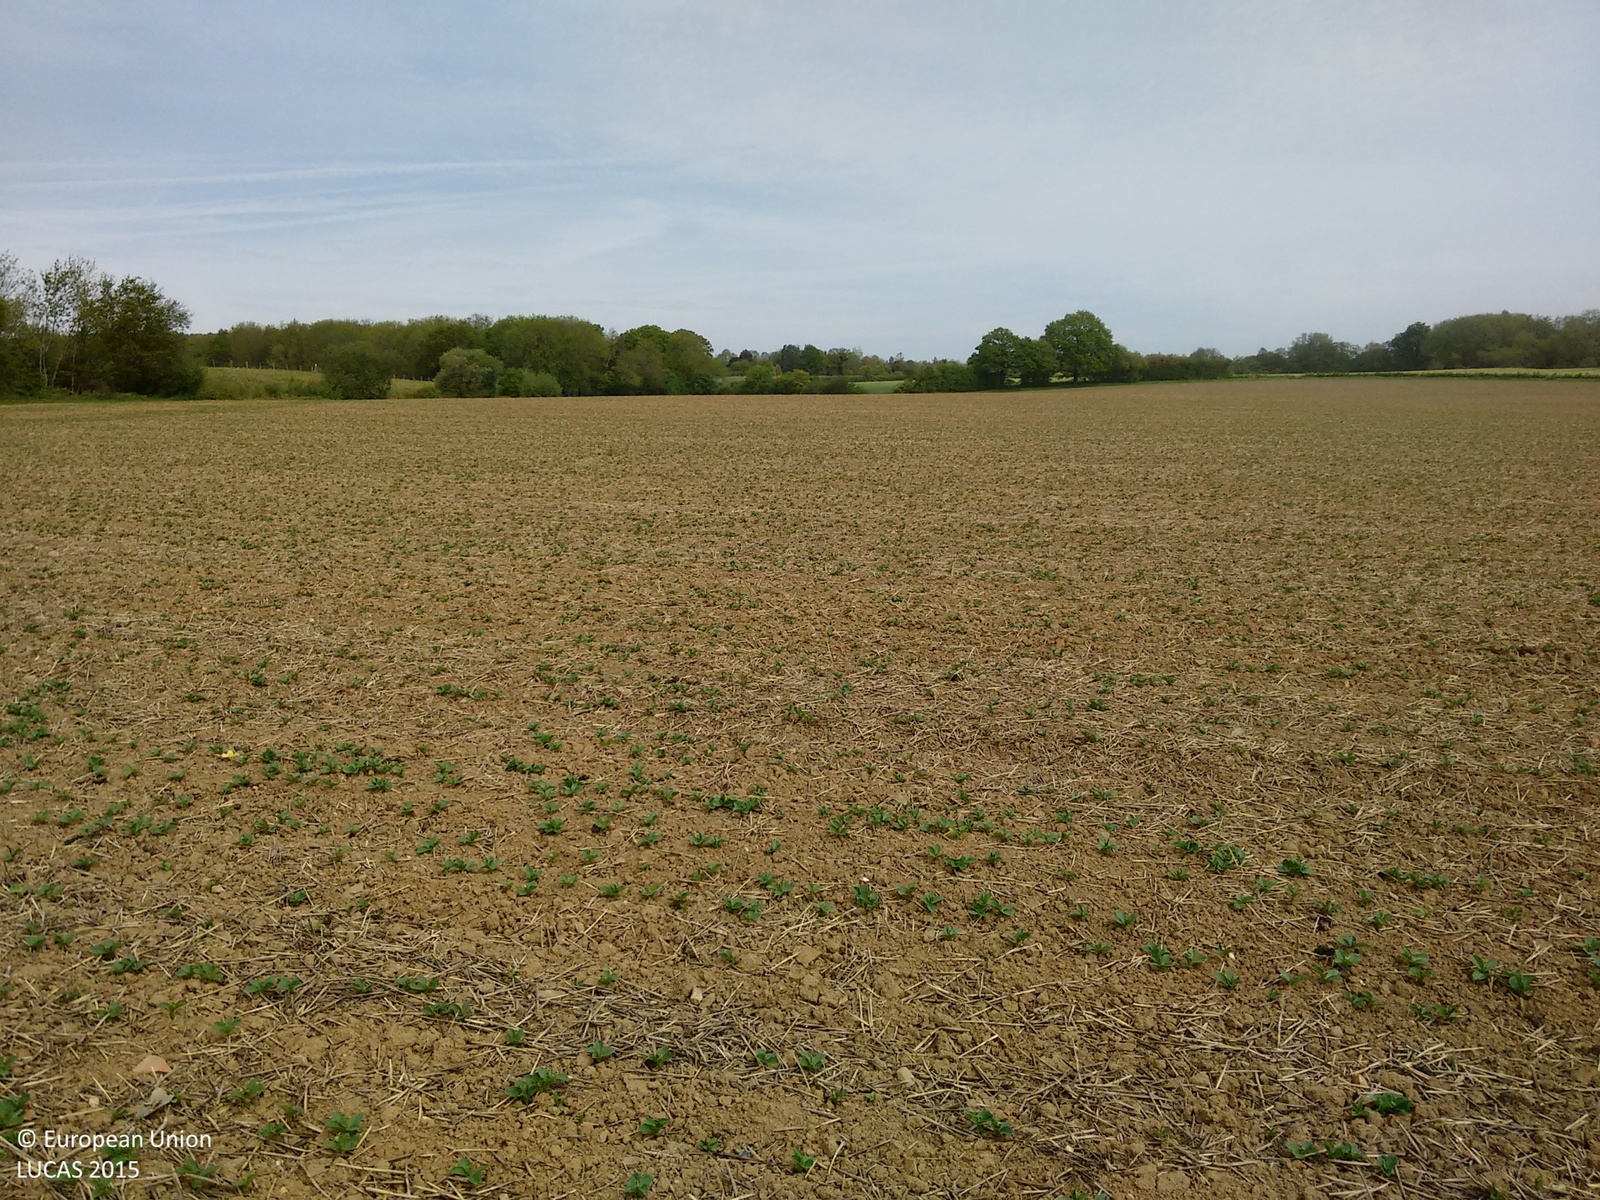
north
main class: Cropland
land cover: Dry pulses
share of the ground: 10 - 25 %
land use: Agriculture (excluding fallow land and kitchen gardens)
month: May
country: GB
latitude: 51.2418
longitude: 0.3591
